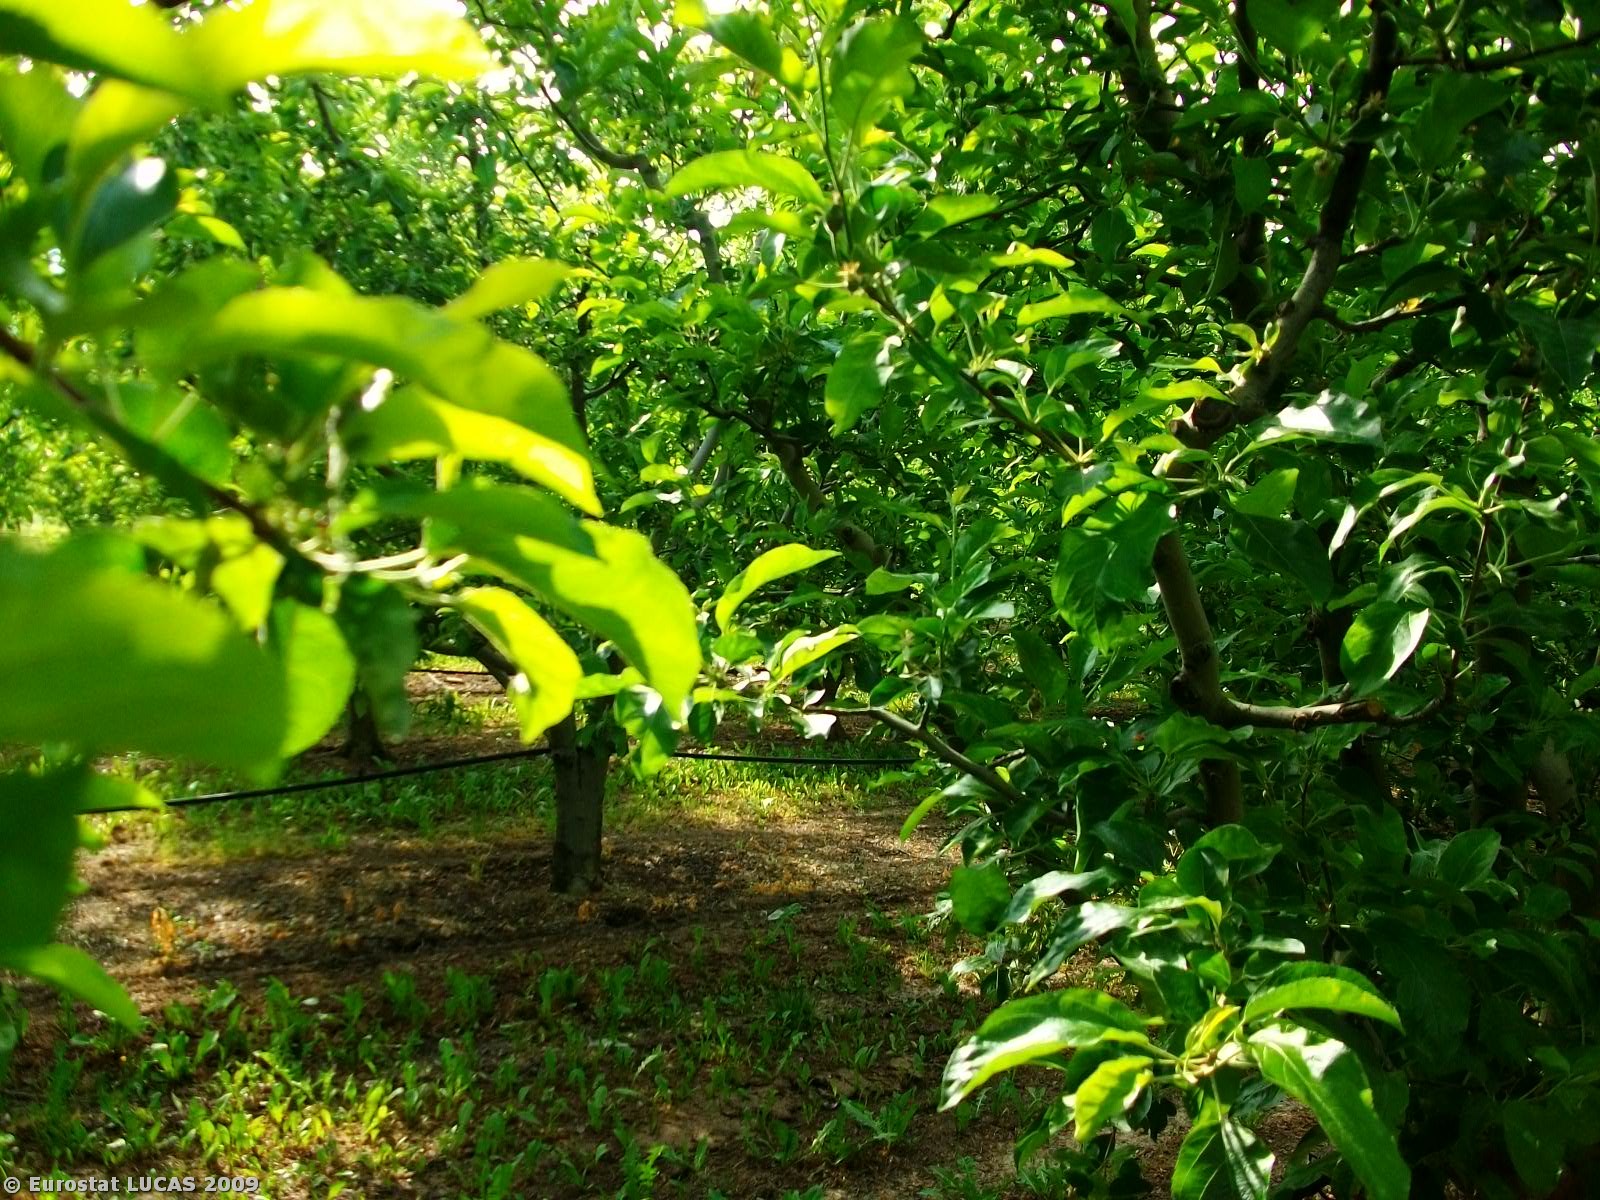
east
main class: Cropland
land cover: Apple fruit
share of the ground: > 75 %
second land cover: Grassland with sparse tree/shrub cover
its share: 50 - 75 %
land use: Agriculture (excluding fallow land and kitchen gardens)
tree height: > 5 m
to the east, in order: Apple fruit; Grassland with sparse tree/shrub cover; Tracks; Apple fruit; Broadleaved woodland; Apple fruit; Grassland with sparse tree/shrub cover
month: May
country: GR
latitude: 40.7335
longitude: 21.8498
